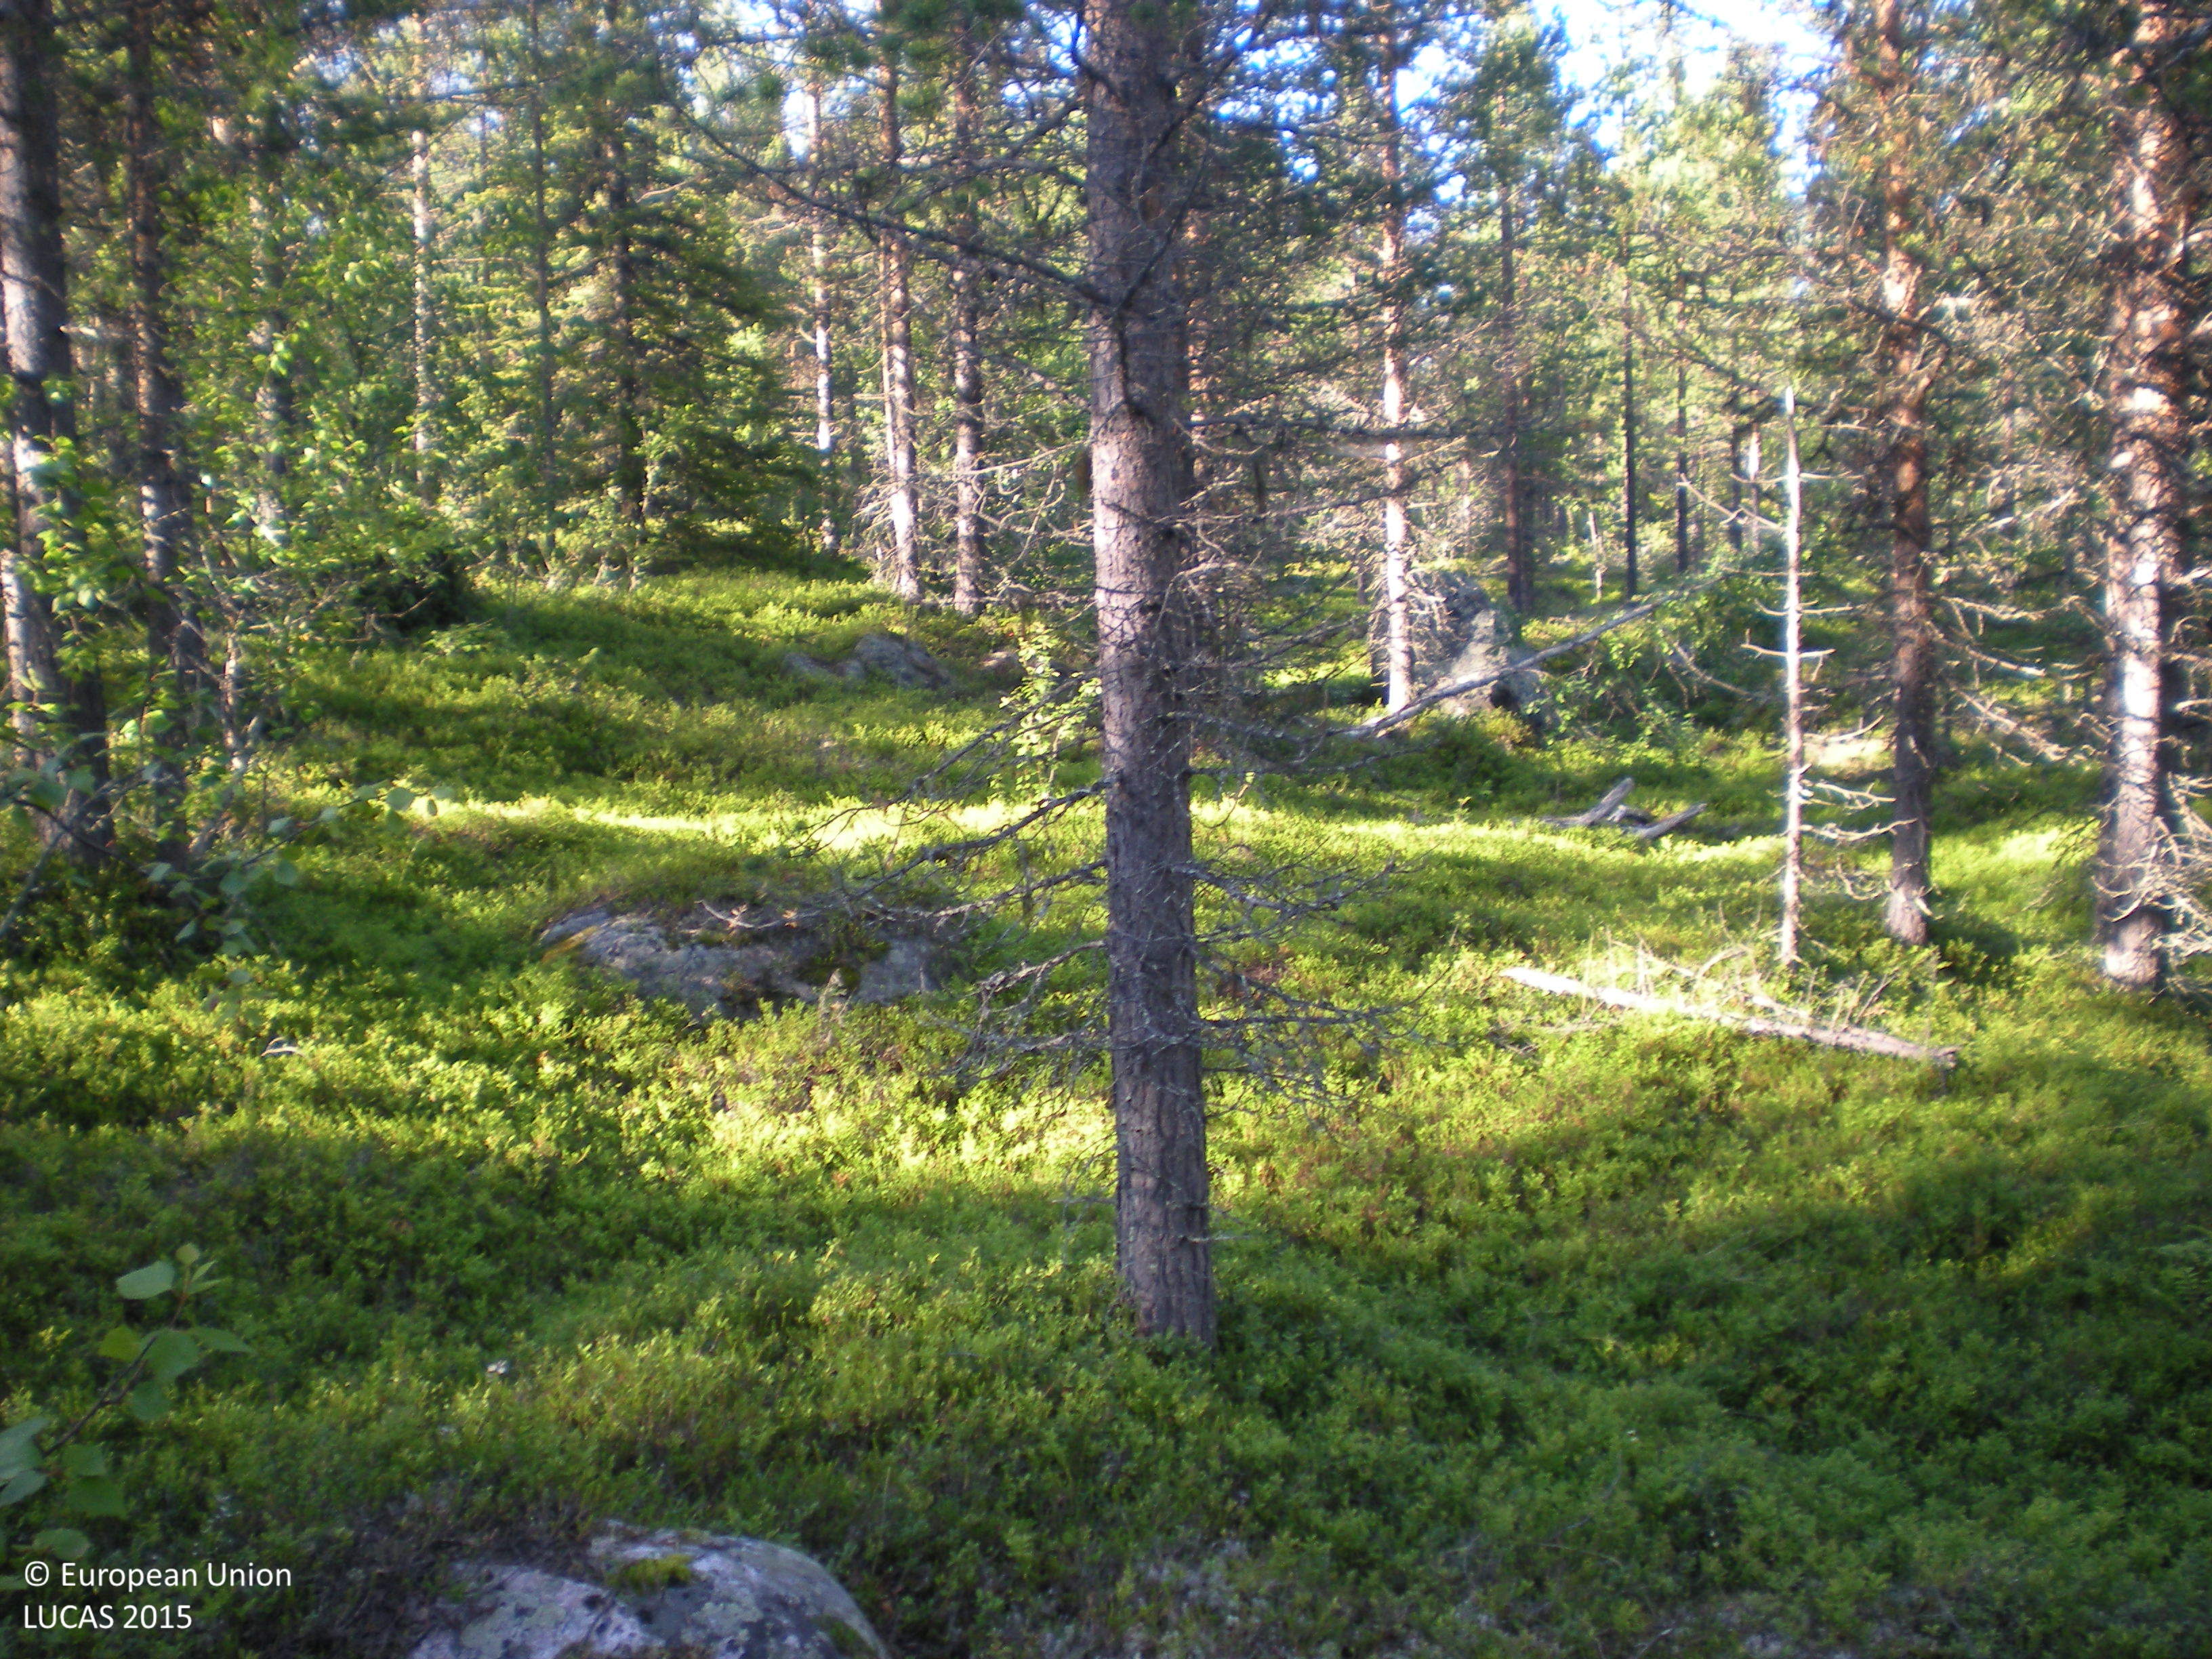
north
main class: Woodland
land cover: Pine dominated coniferous woodland
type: boreal forest
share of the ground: 50 - 75 %
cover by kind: coniferous forest trees 65 %, shrubs 25 %, broadleaved forest trees 5 %, lichens and mosses 5 %
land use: Forestry
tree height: > 5 m
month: August
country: SE
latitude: 66.3189
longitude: 18.0967
